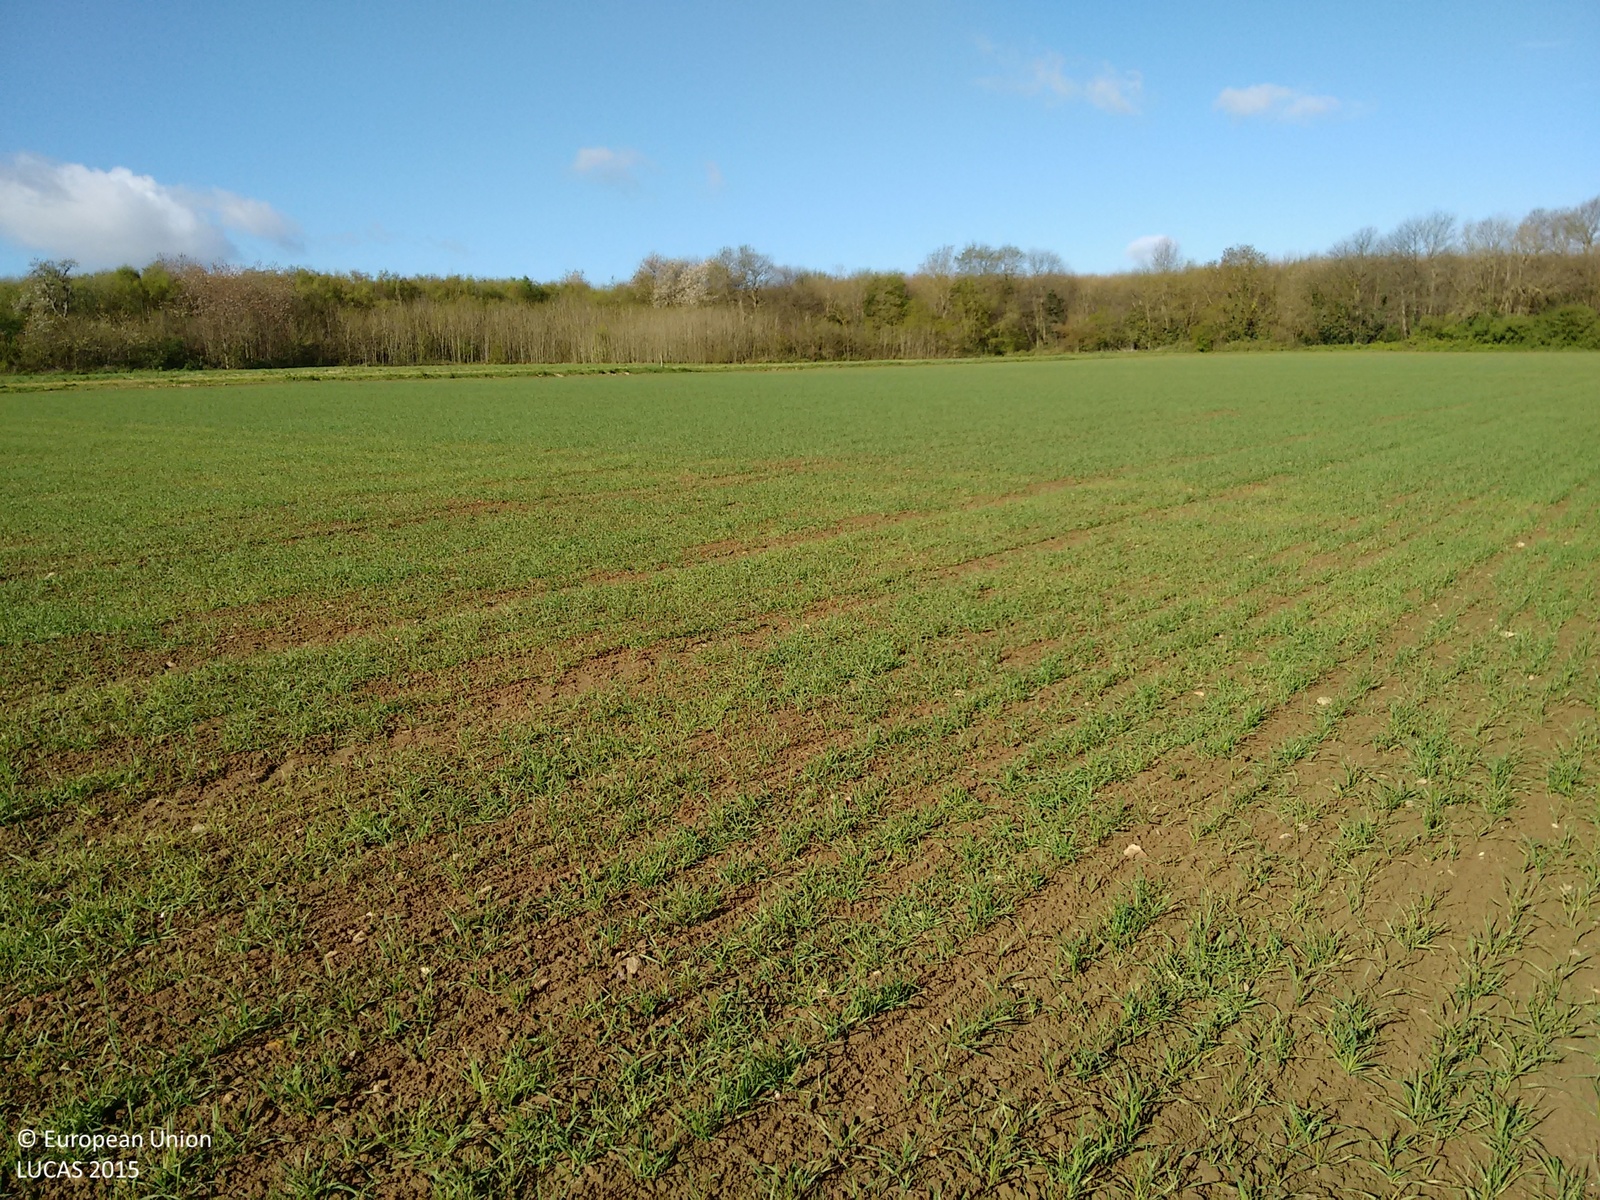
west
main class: Cropland
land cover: Common wheat
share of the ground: 25 - 50 %
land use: Agriculture (excluding fallow land and kitchen gardens)
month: April
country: GB
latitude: 51.2975
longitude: 0.3762
